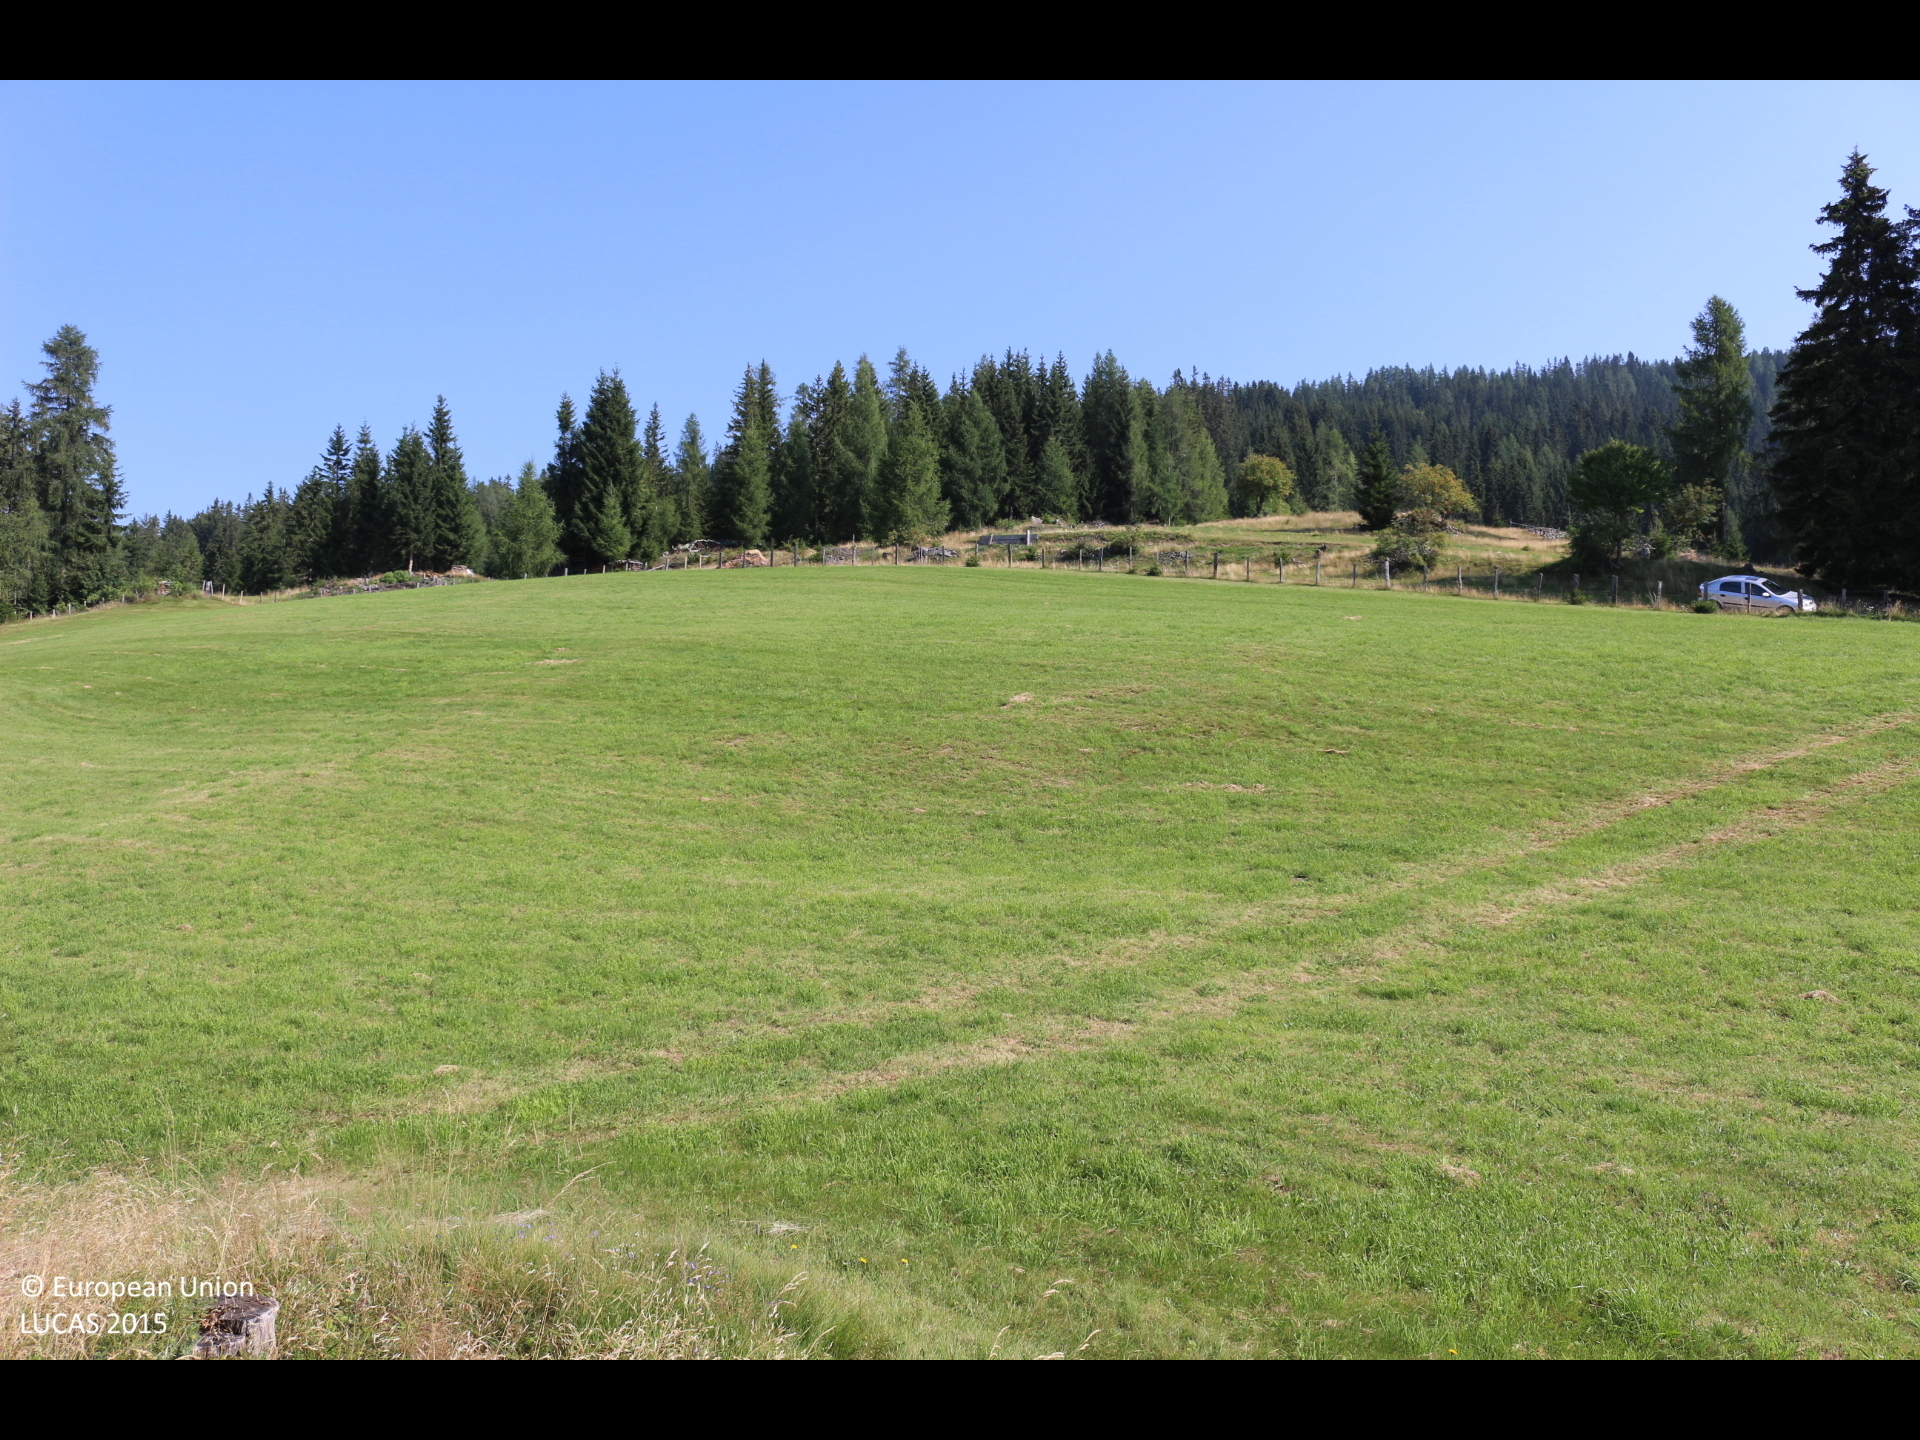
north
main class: Woodland
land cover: Broadleaved woodland
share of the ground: 50 - 75 %
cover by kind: broadleaved forest trees 70 %, herbaceous plants 25 %, consolidated bare surface 5 %
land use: Agriculture (excluding fallow land and kitchen gardens)
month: August
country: AT
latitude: 46.8875
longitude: 14.0530
